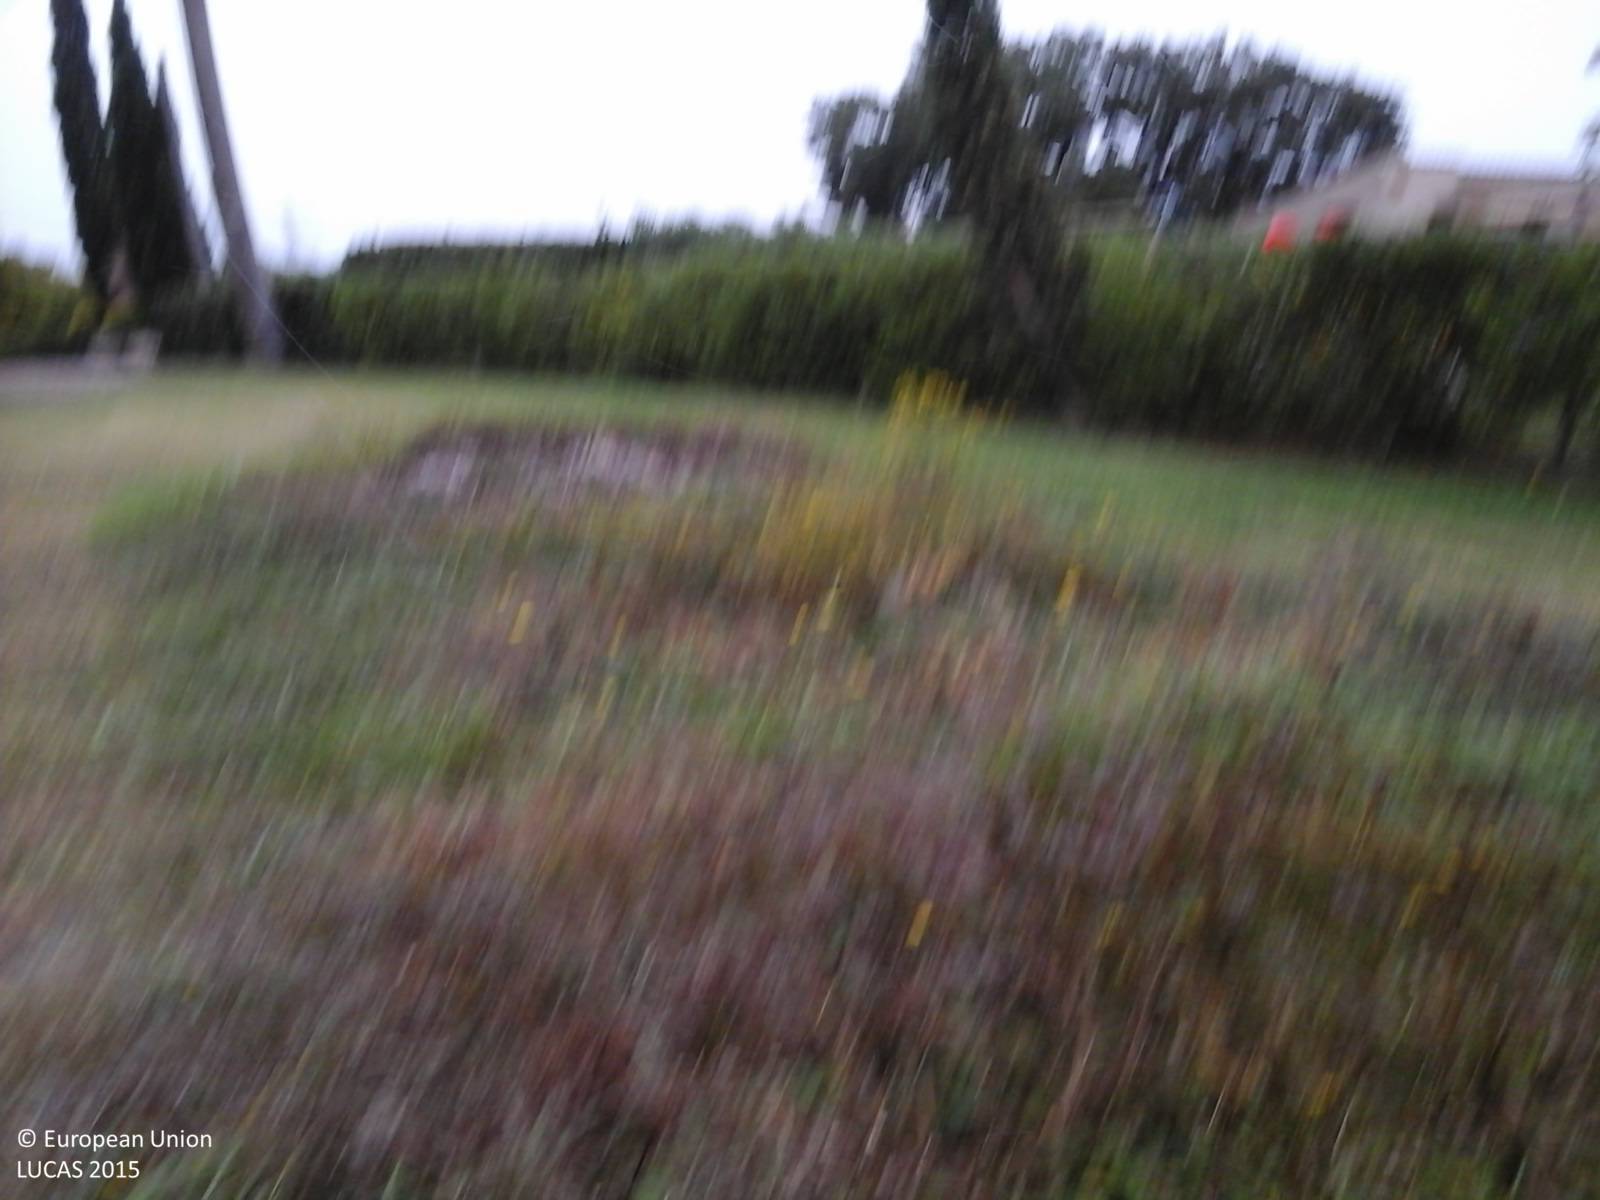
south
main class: Grassland
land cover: Grassland without tree/shrub cover
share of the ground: 50 - 75 %
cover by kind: herbaceous plants 100 %
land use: Agriculture (excluding fallow land and kitchen gardens)
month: October
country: IT
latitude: 43.5916
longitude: 10.5064
